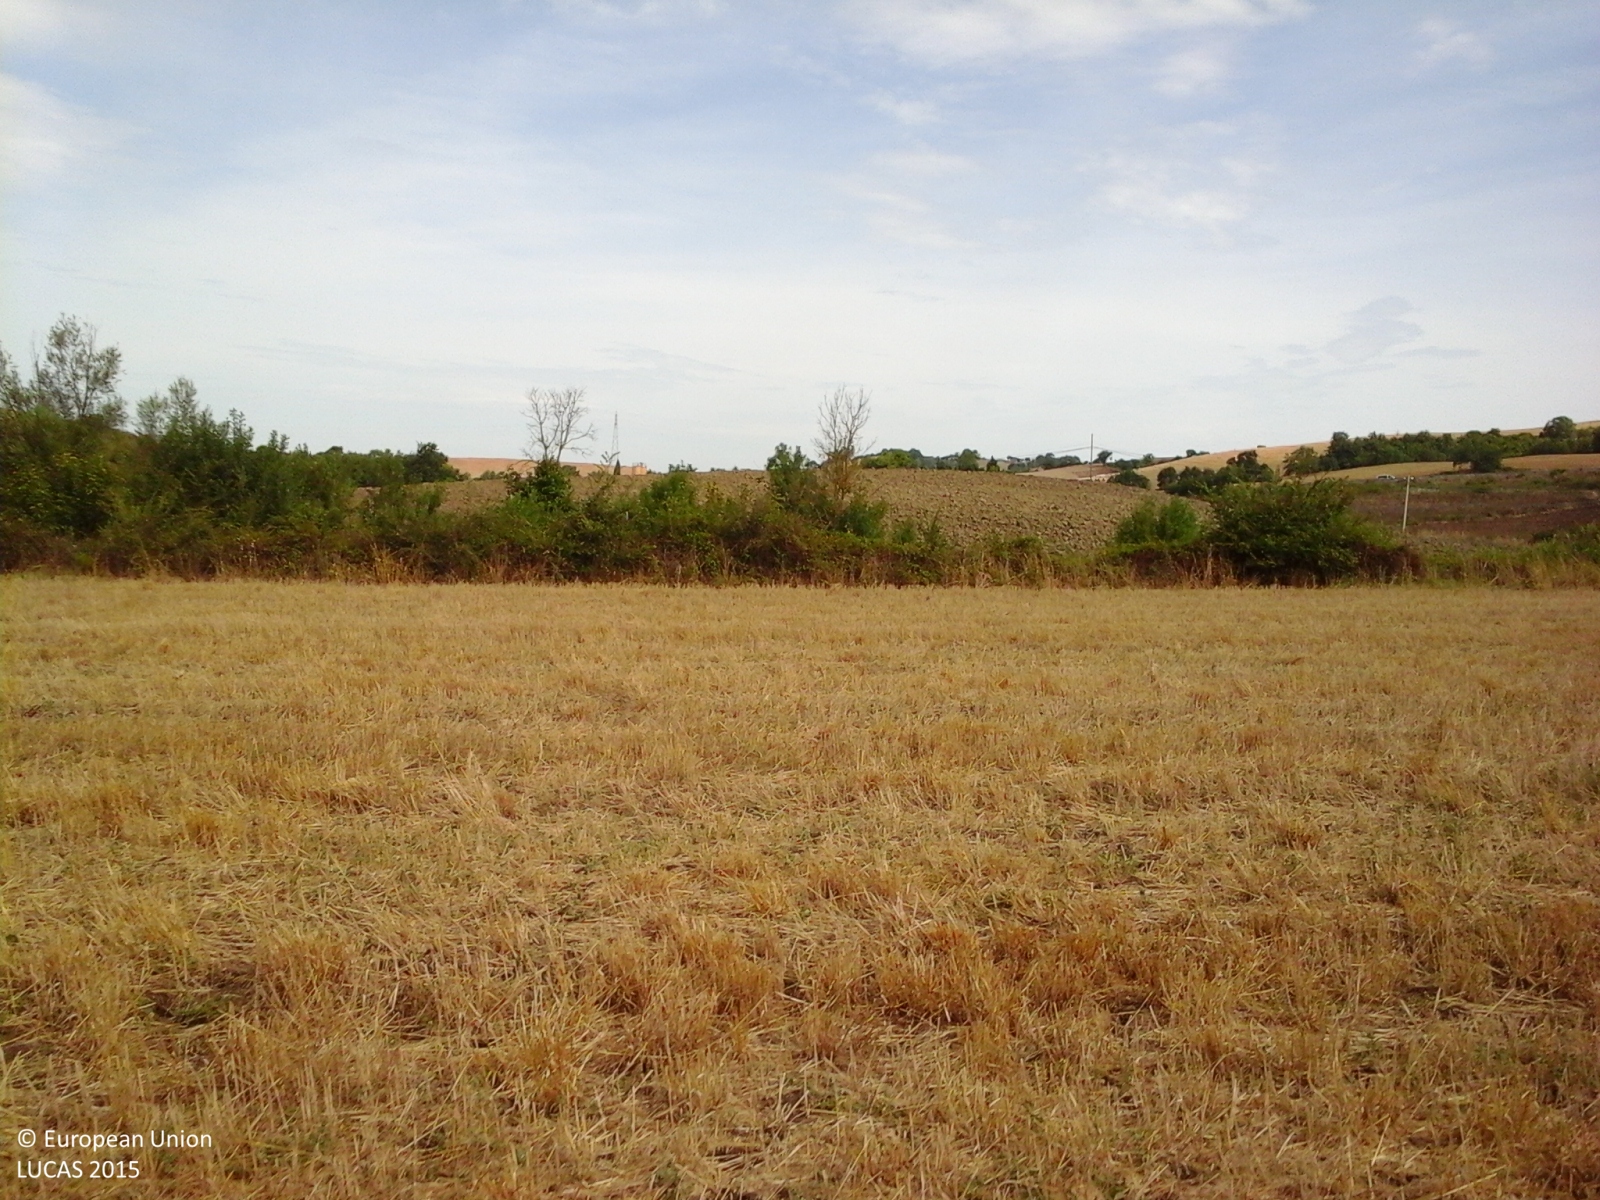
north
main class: Cropland
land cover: Durum wheat
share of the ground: > 75 %
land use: Agriculture (excluding fallow land and kitchen gardens)
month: August
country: IT
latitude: 42.5715
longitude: 11.4448
